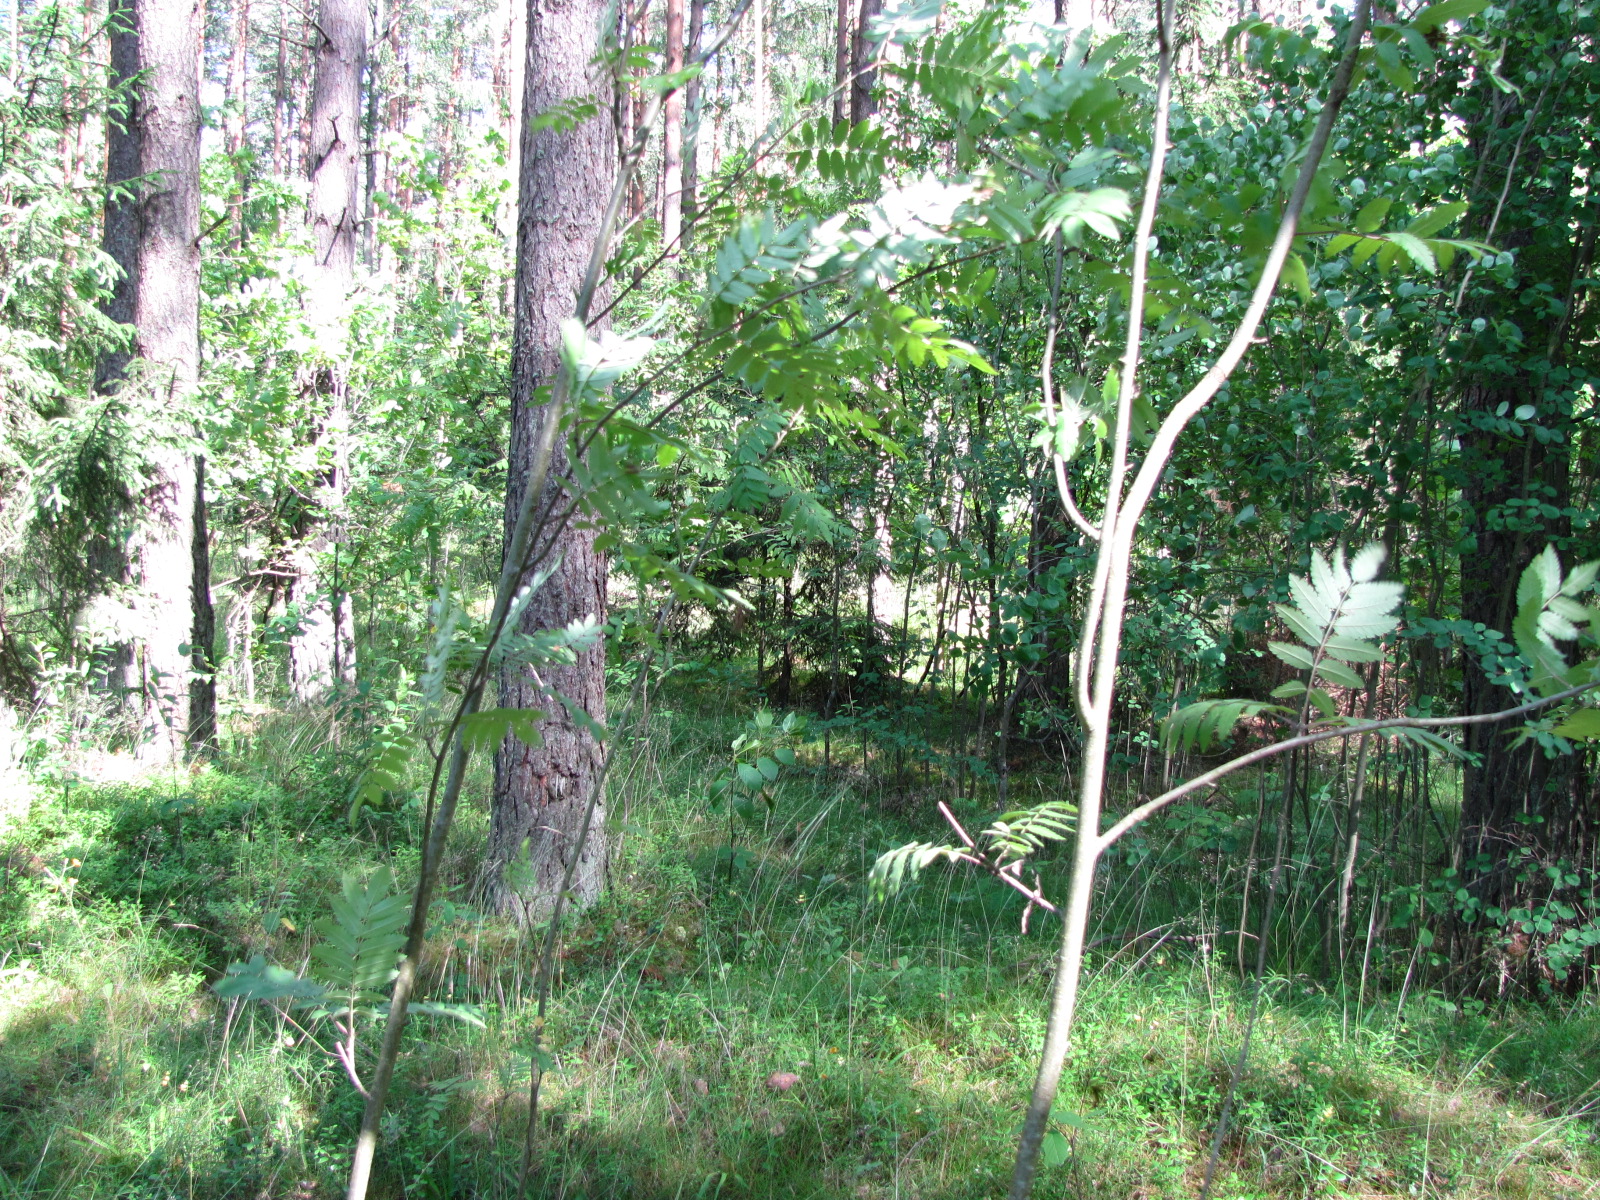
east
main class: Woodland
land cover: Pine dominated mixed woodland
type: hemiboreal forest and nemoral coniferous forest and mixed broadleaved-coniferous forest
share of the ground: > 75 %
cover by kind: coniferous forest trees 55 %, broadleaved forest trees 25 %, herbaceous plants 15 %, shrubs 5 %
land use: Forestry
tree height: > 5 m
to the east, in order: Pine dominated mixed woodland
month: July
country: LV
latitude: 57.0097
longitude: 24.3002
